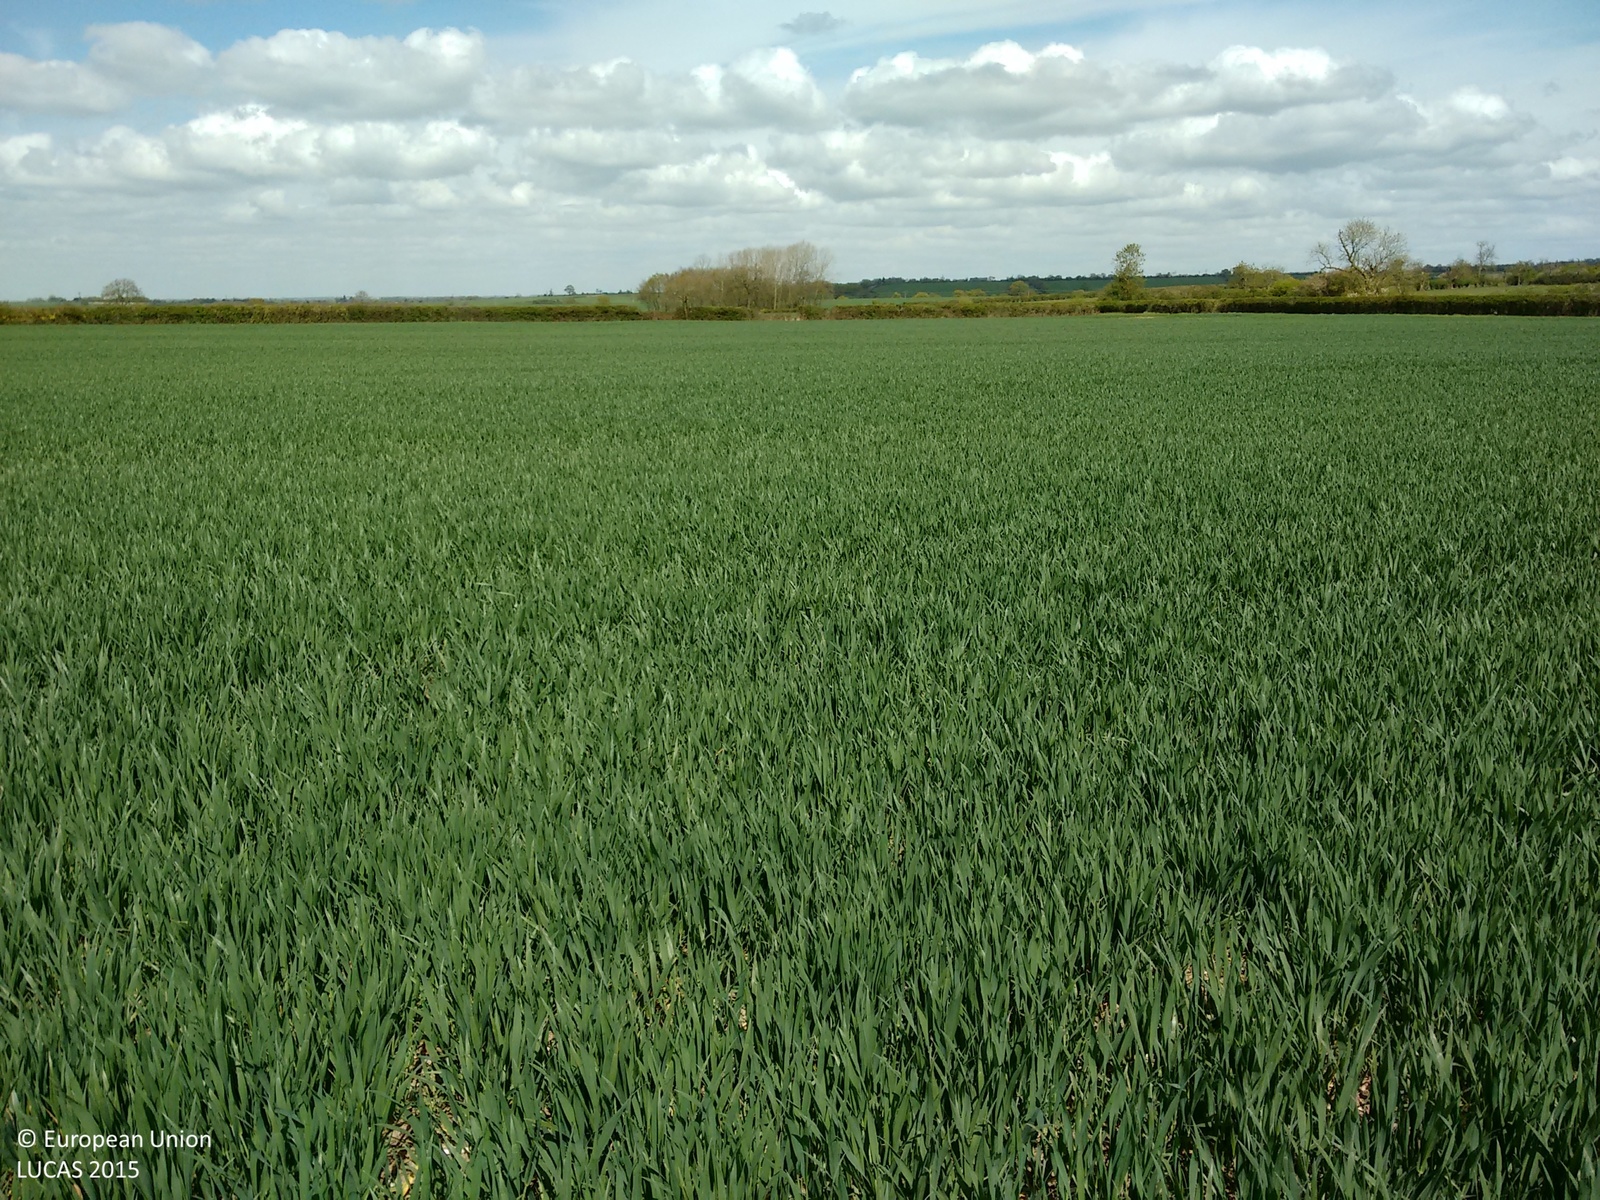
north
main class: Cropland
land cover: Common wheat
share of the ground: > 75 %
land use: Agriculture (excluding fallow land and kitchen gardens)
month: May
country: GB
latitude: 52.0068
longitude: -0.8373
